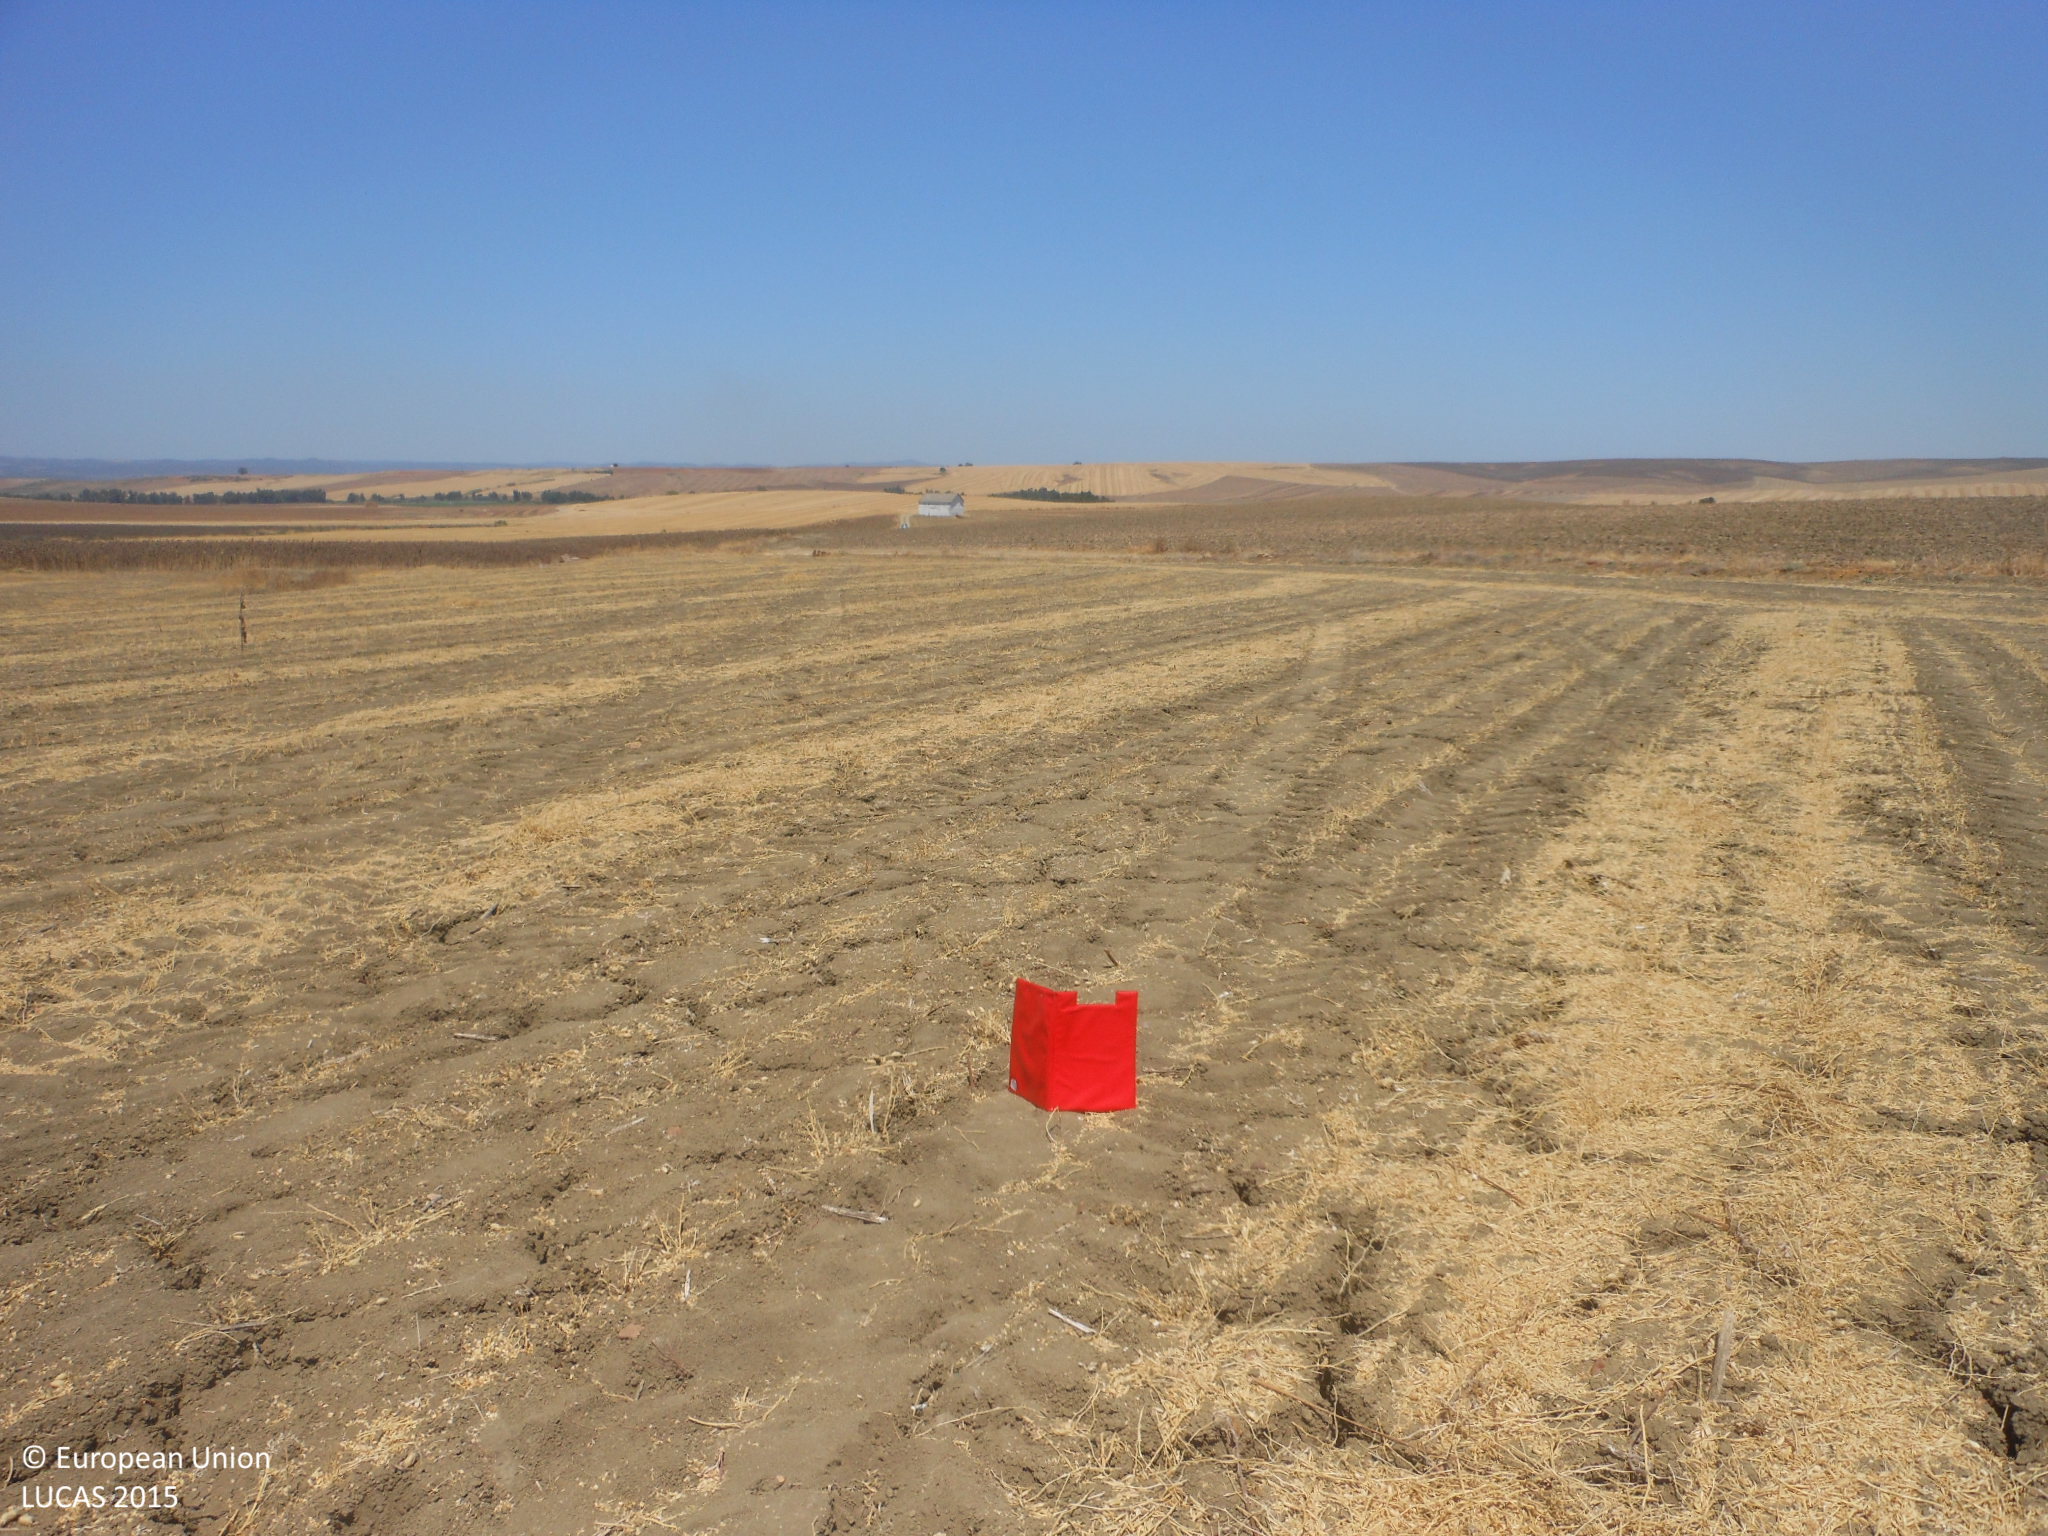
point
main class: Cropland
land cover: Dry pulses
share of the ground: < 10 %
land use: Agriculture (excluding fallow land and kitchen gardens)
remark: Harvested field
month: July
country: ES
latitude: 37.5201
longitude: -5.6000
